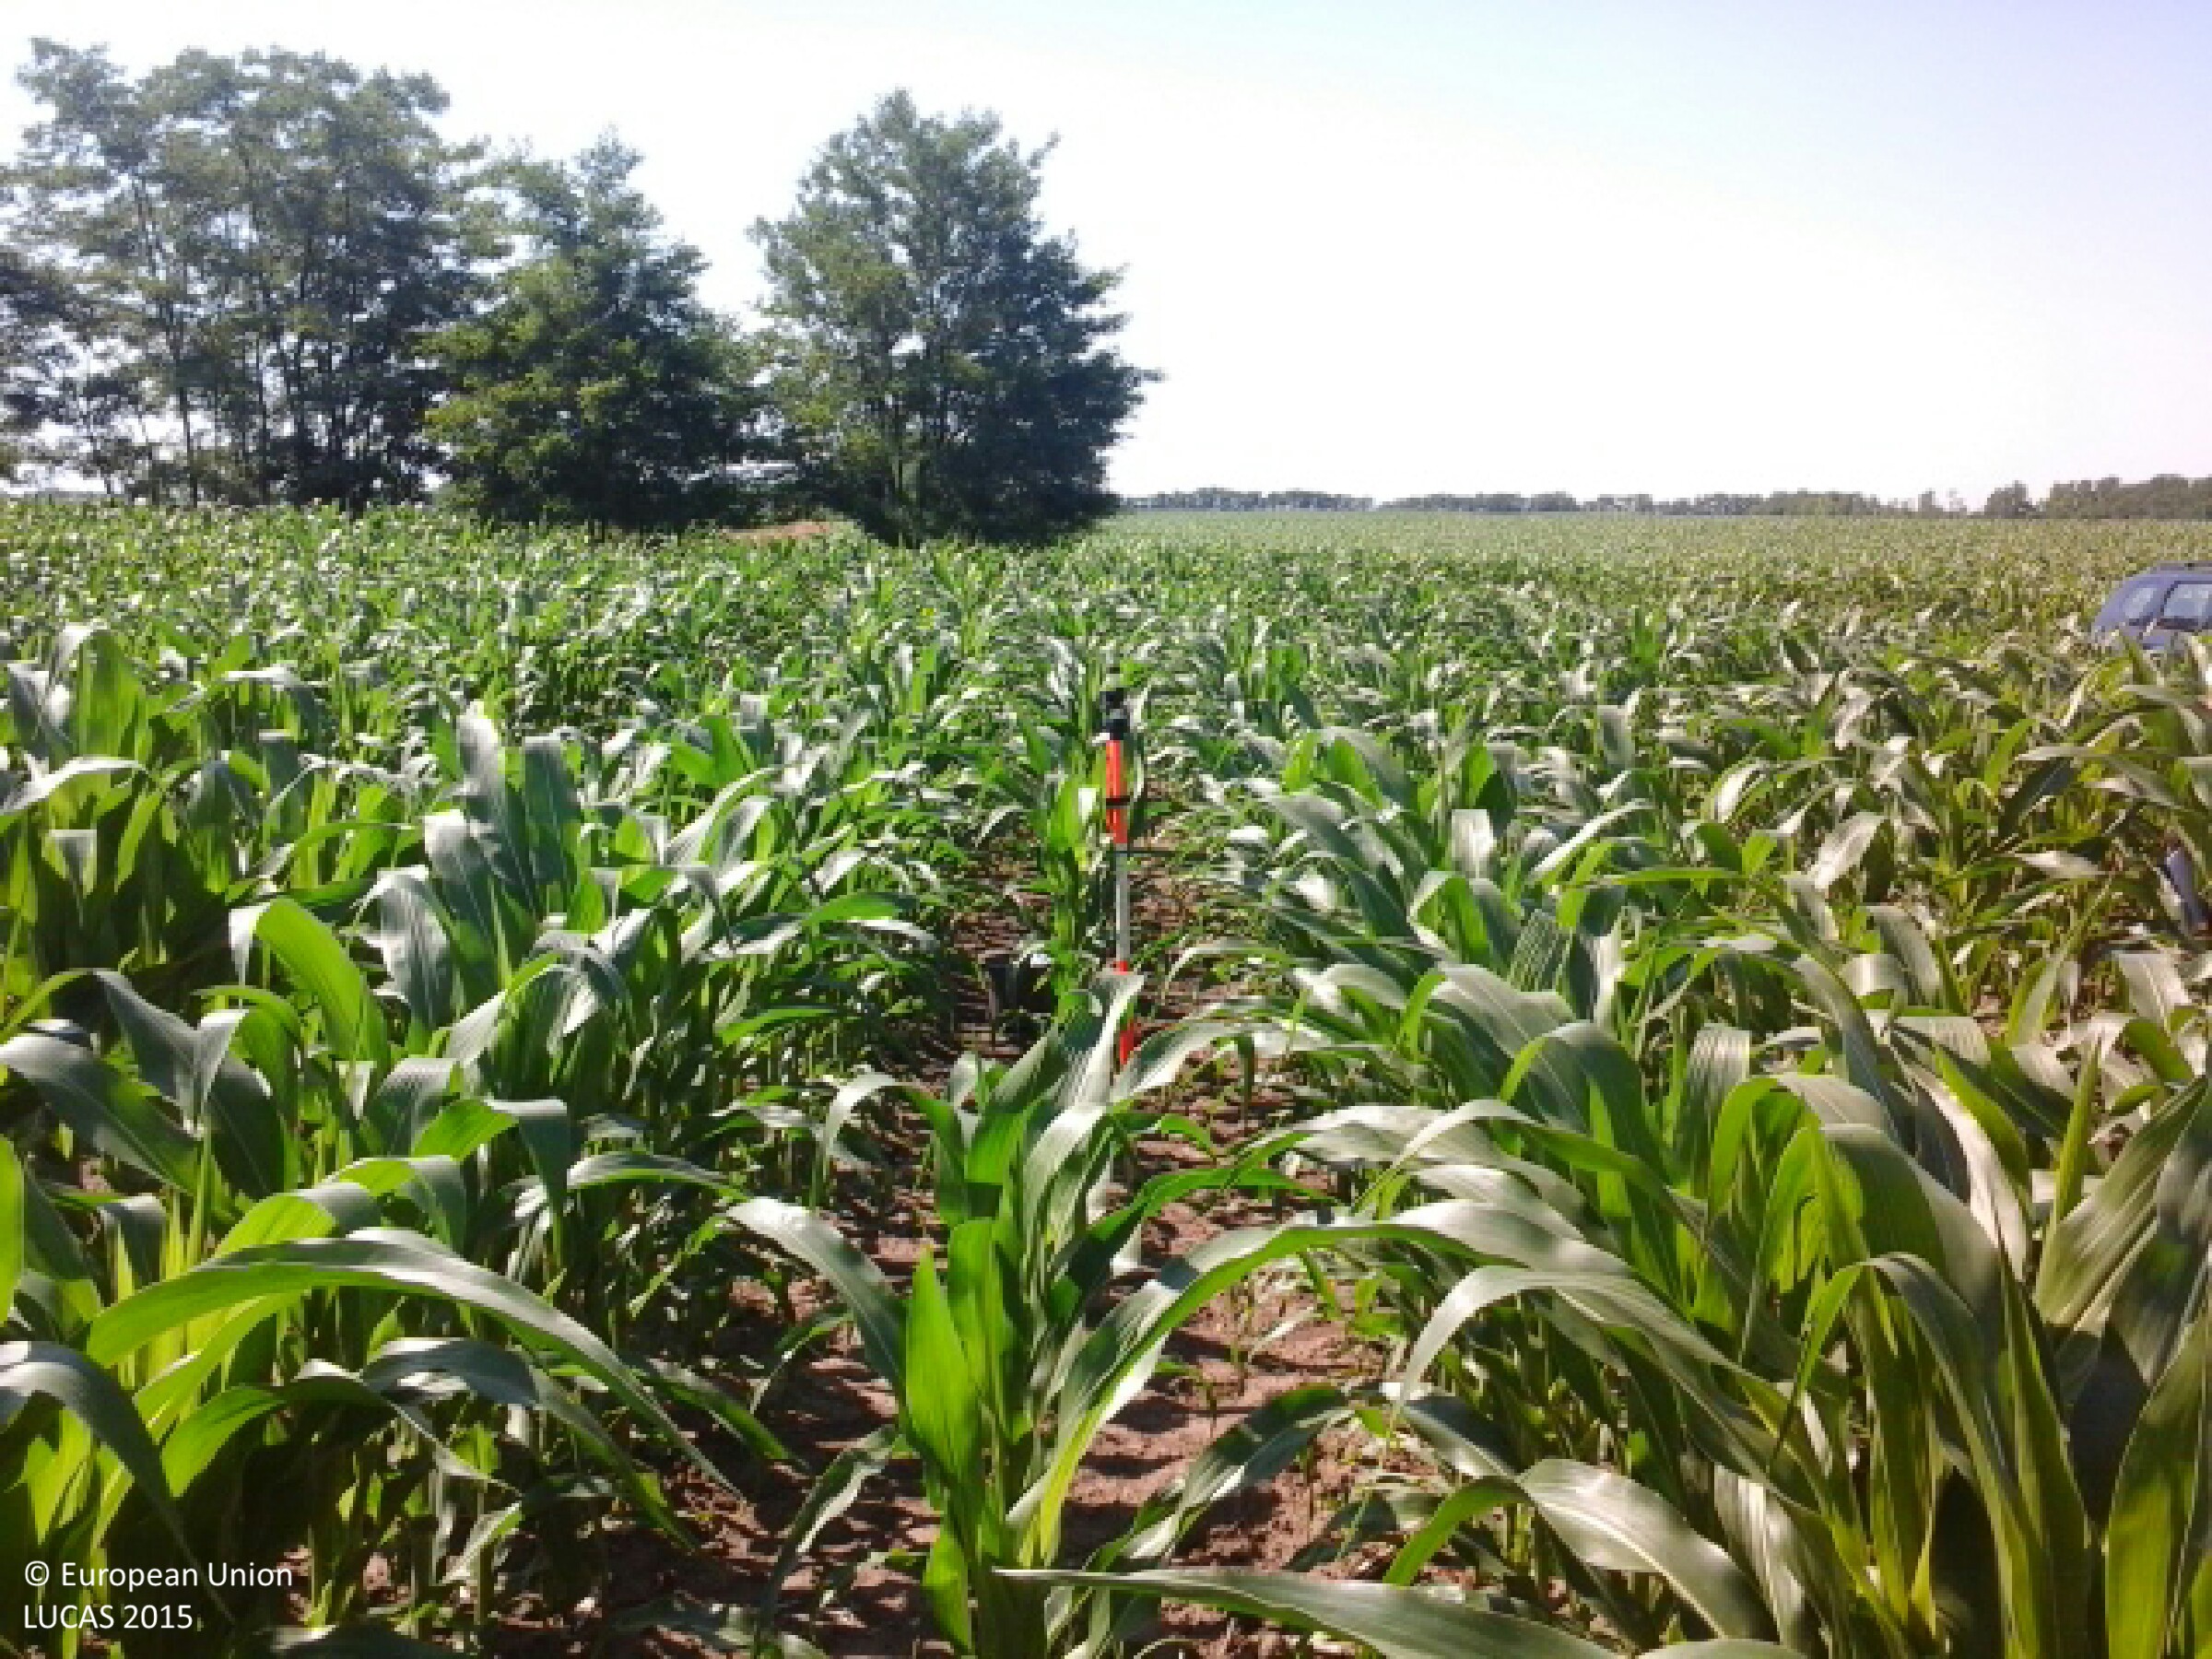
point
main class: Cropland
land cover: Maize
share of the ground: 50 - 75 %
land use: Agriculture (excluding fallow land and kitchen gardens)
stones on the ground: < 10 %
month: June
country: HU
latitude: 47.7950
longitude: 21.7285
